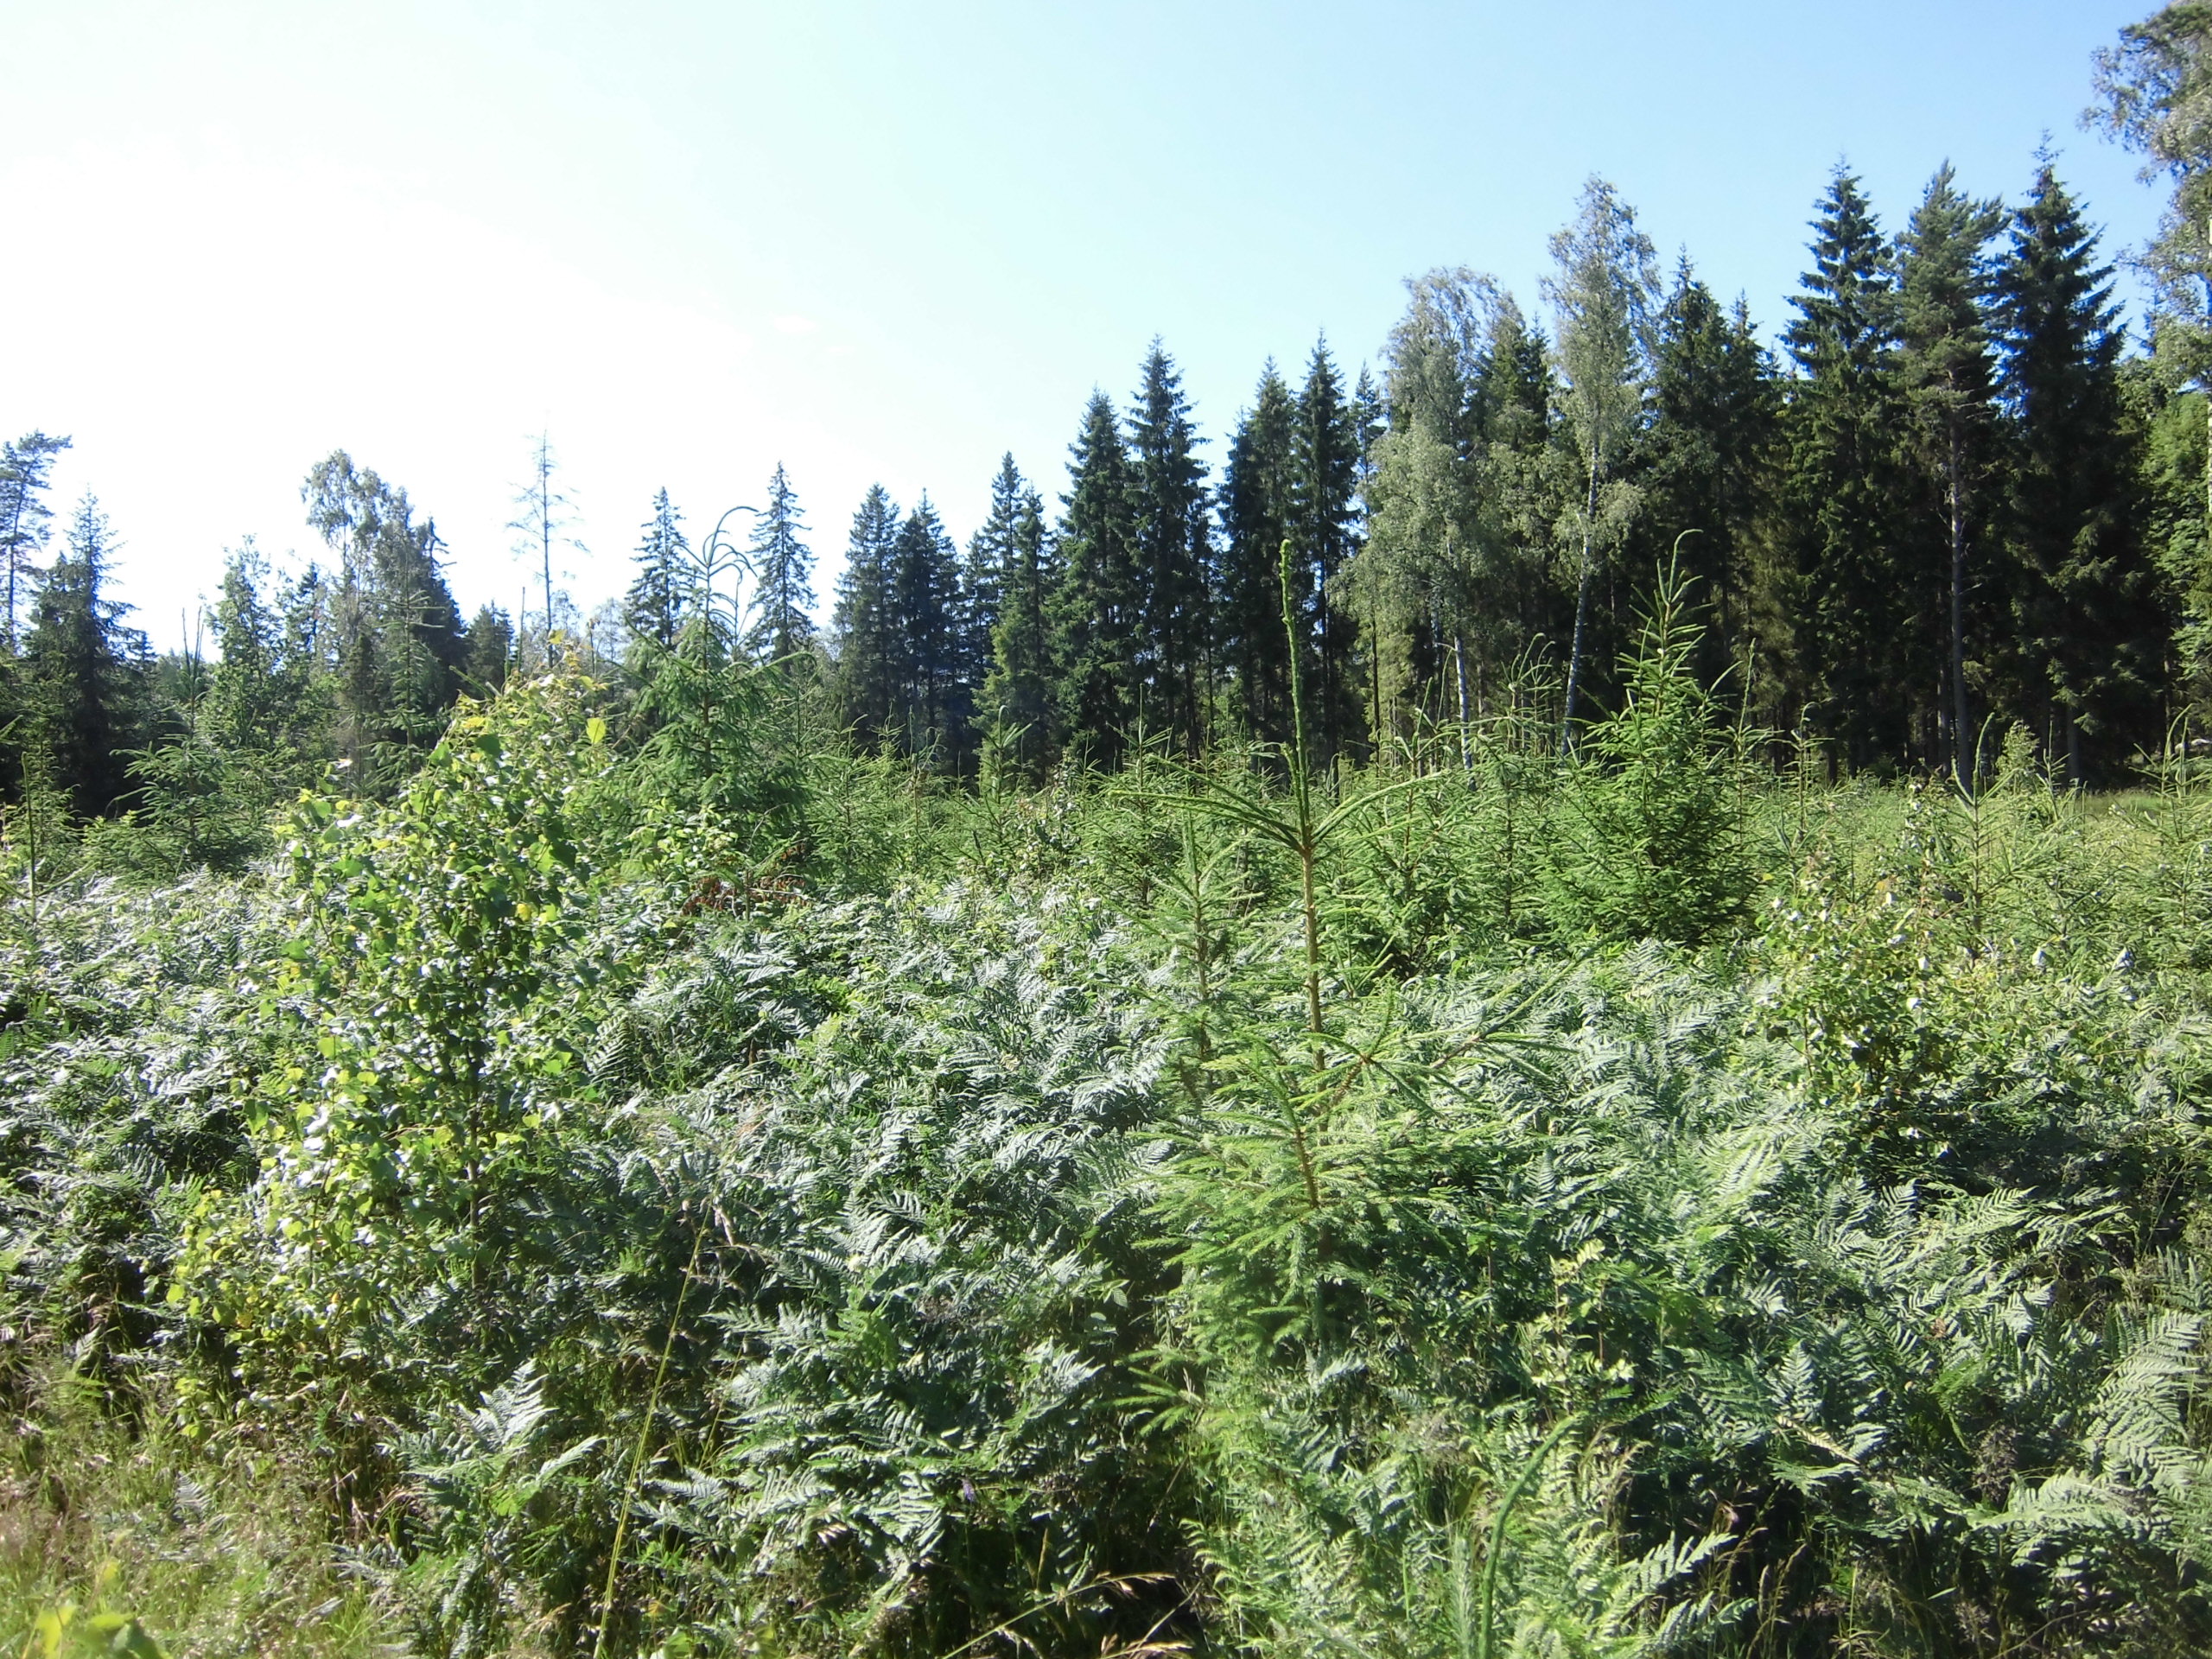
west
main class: Woodland
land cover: Spruce dominated mixed woodland
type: boreal forest
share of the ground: 25 - 50 %
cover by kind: herbaceous plants 35 %, shrubs 30 %, coniferous forest trees 15 %, broadleaved forest trees 15 %, lichens and mosses 5 %
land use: Forestry
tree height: < 5 m
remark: Clear cut
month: July
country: SE
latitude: 57.2822
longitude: 15.3884
